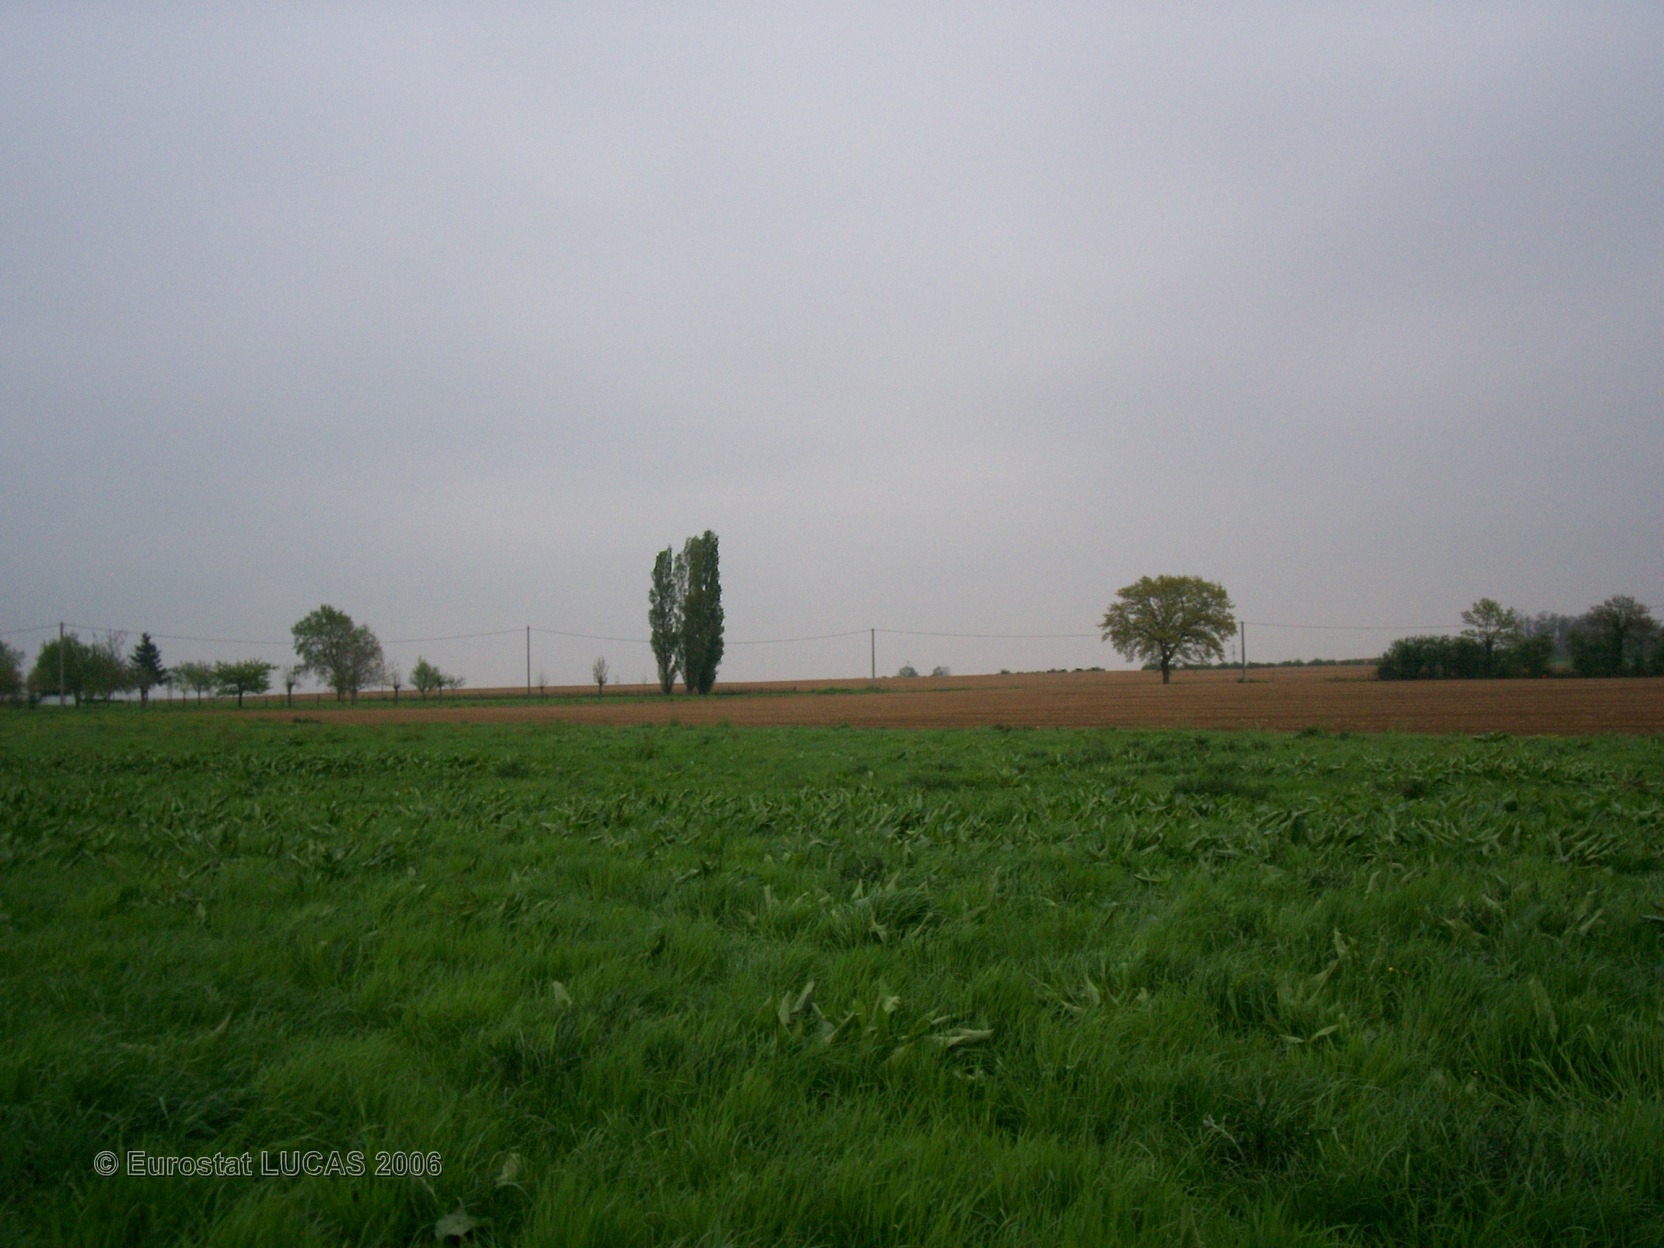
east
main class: Grassland
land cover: Grassland without tree/shrub cover
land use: Agriculture (excluding fallow land and kitchen gardens)
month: April
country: FR
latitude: 46.0261
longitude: 4.7967
